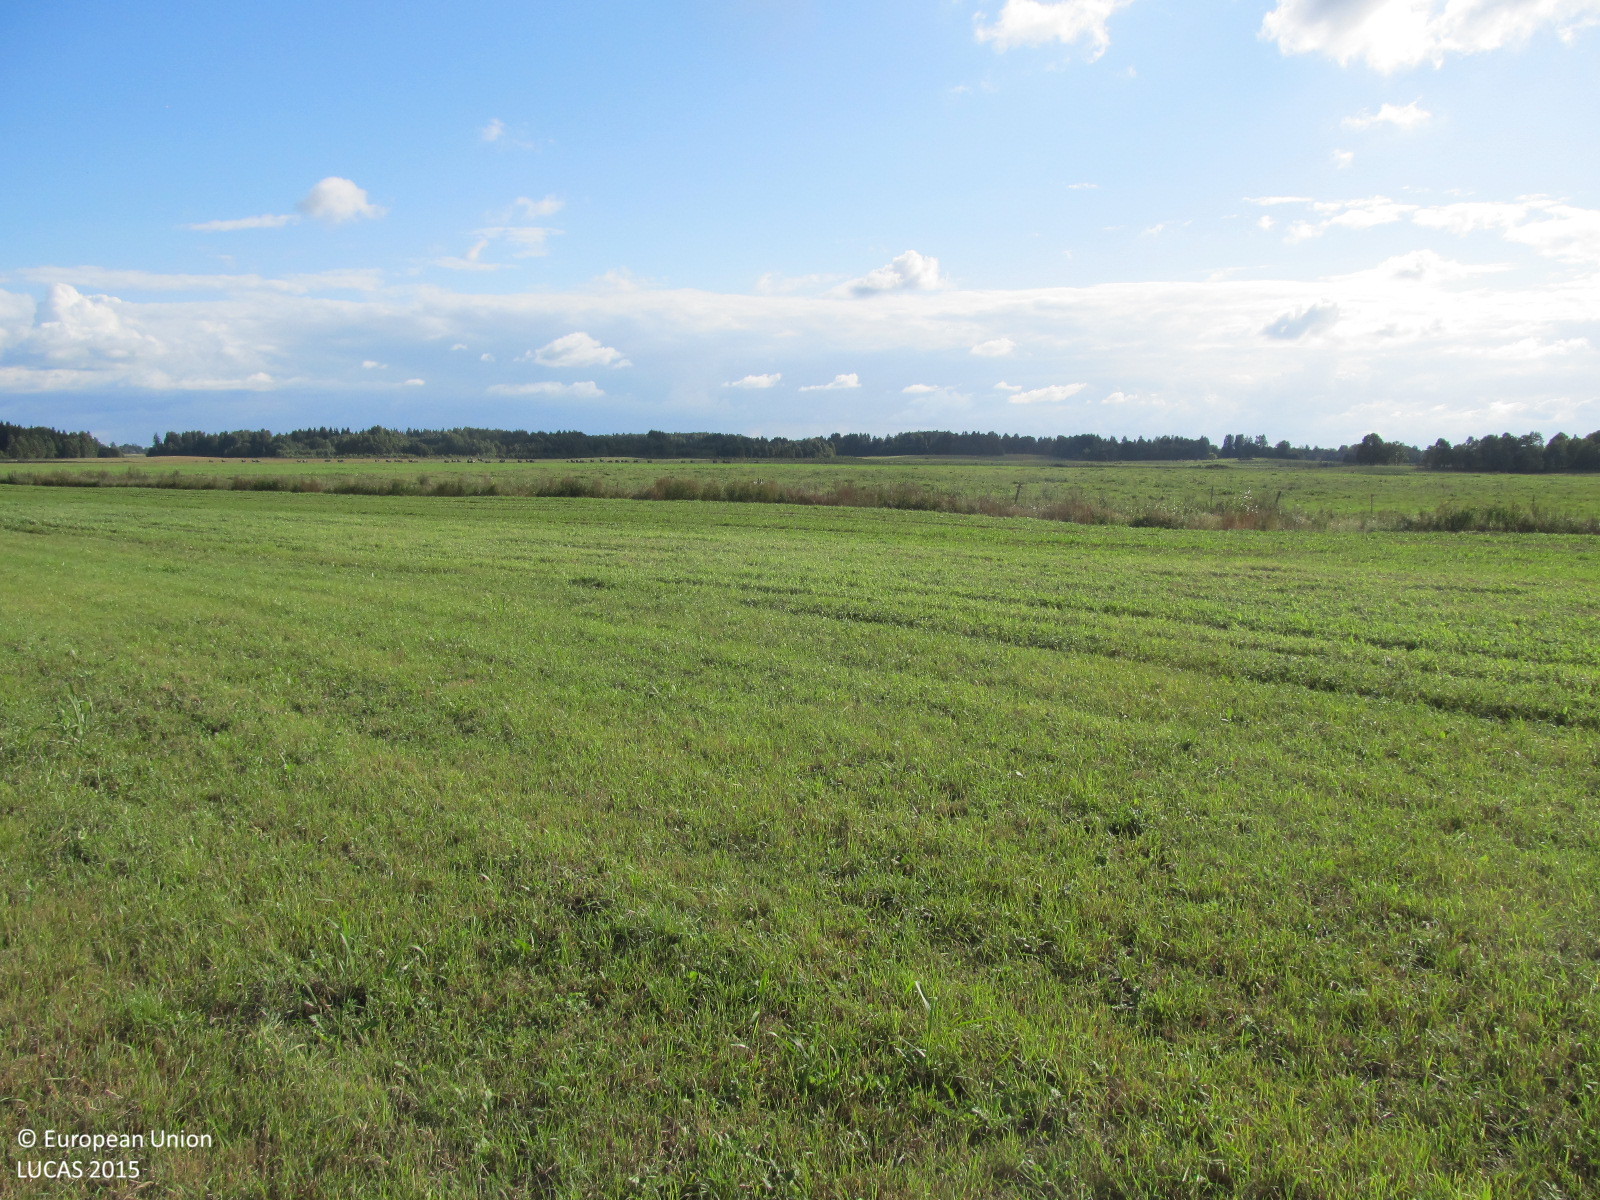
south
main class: Grassland
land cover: Grassland without tree/shrub cover
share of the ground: > 75 %
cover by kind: herbaceous plants 100 %
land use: Agriculture (excluding fallow land and kitchen gardens)
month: September
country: LT
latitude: 55.6690
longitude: 22.6388
